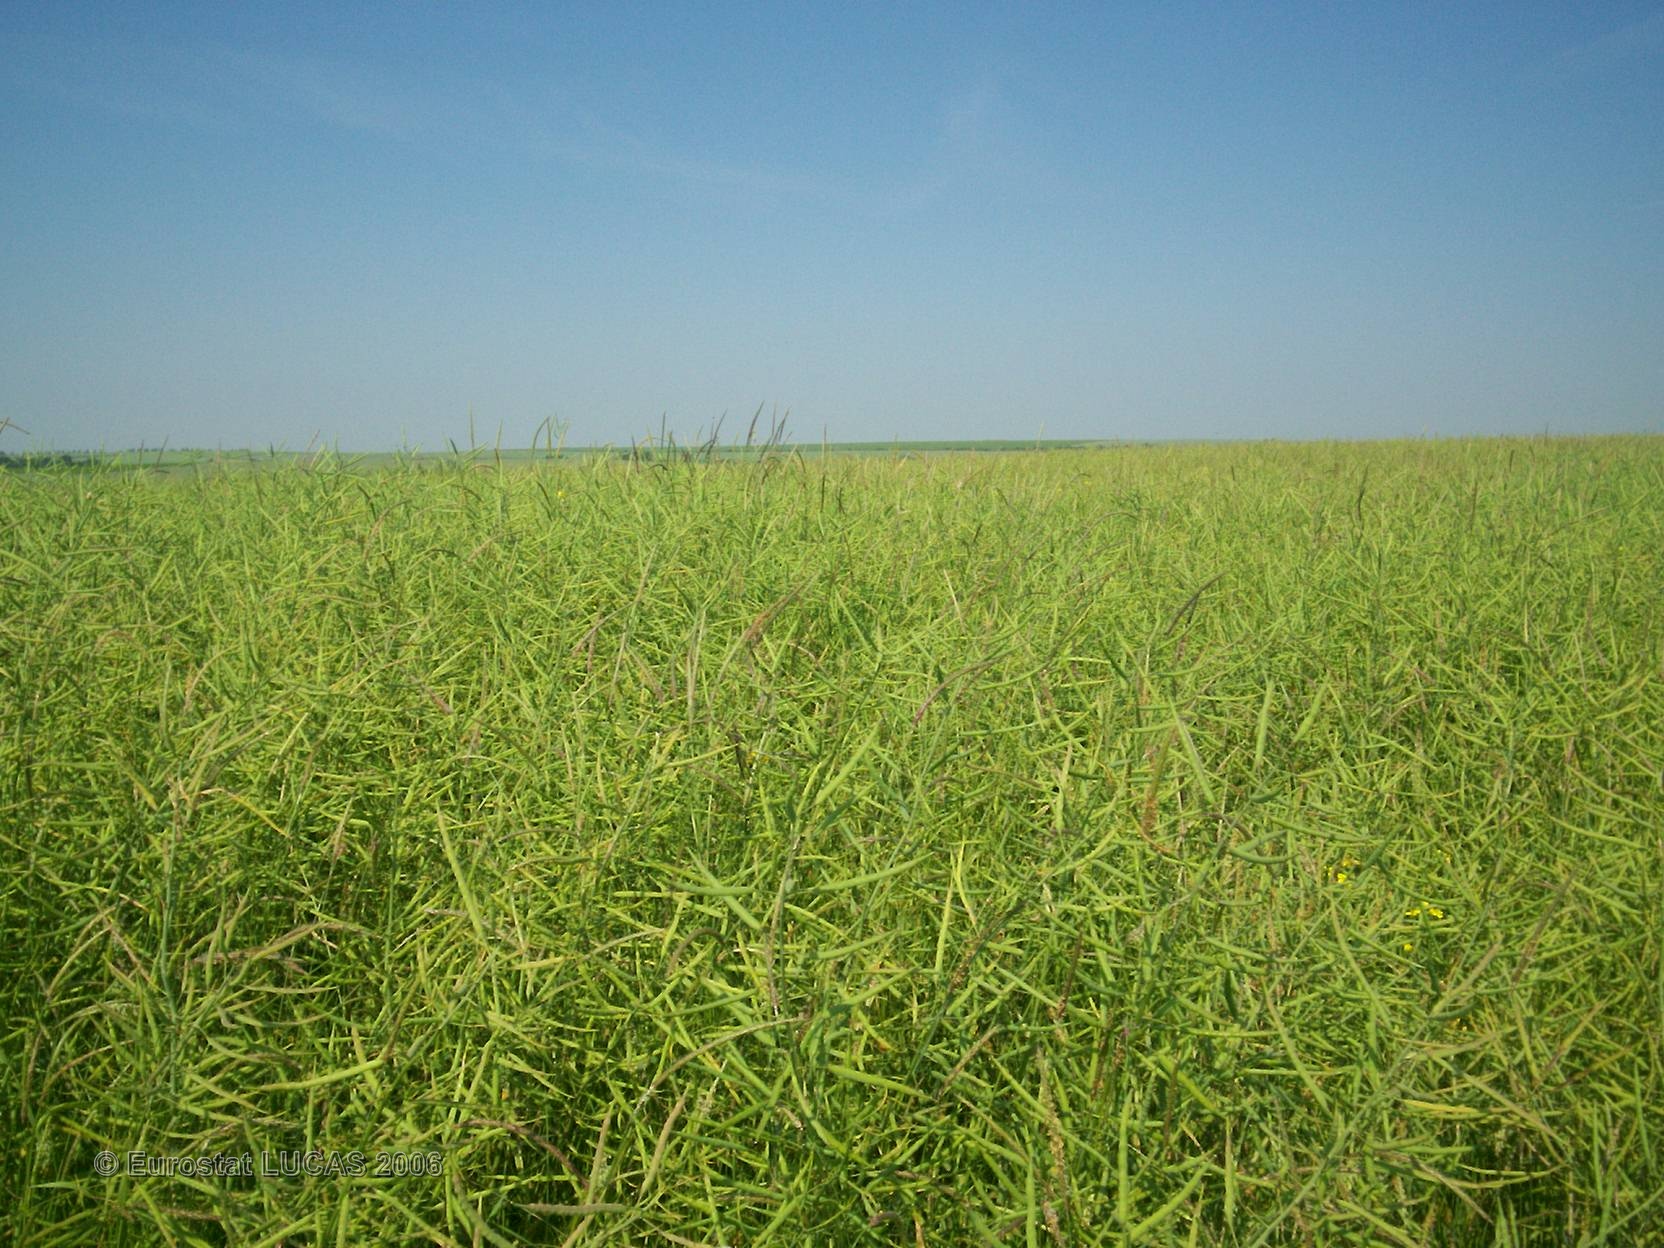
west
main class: Cropland
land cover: Rape and turnip rape
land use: Agriculture (excluding fallow land and kitchen gardens)
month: June
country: FR
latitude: 49.0389
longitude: 4.8129
